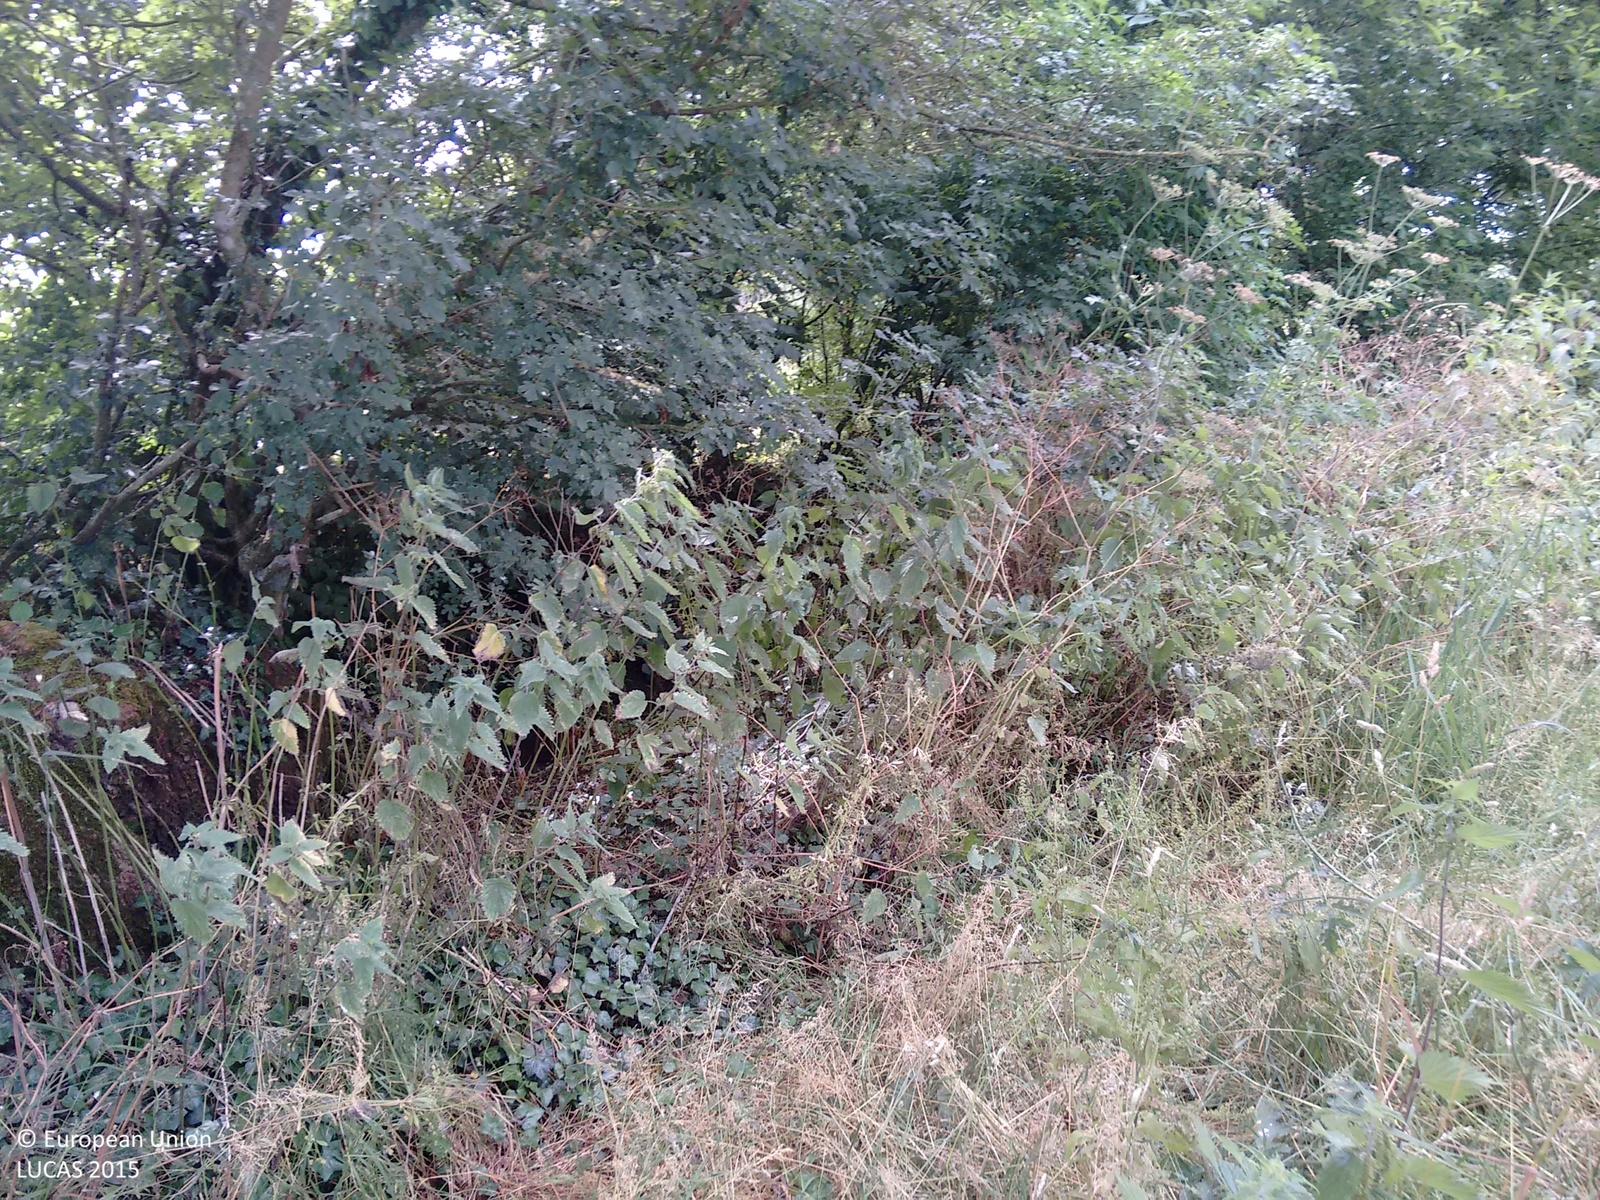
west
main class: Grassland
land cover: Grassland without tree/shrub cover
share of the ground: > 75 %
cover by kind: herbaceous plants 100 %
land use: Agriculture (excluding fallow land and kitchen gardens)
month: July
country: GB
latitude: 51.0297
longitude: -2.4275
